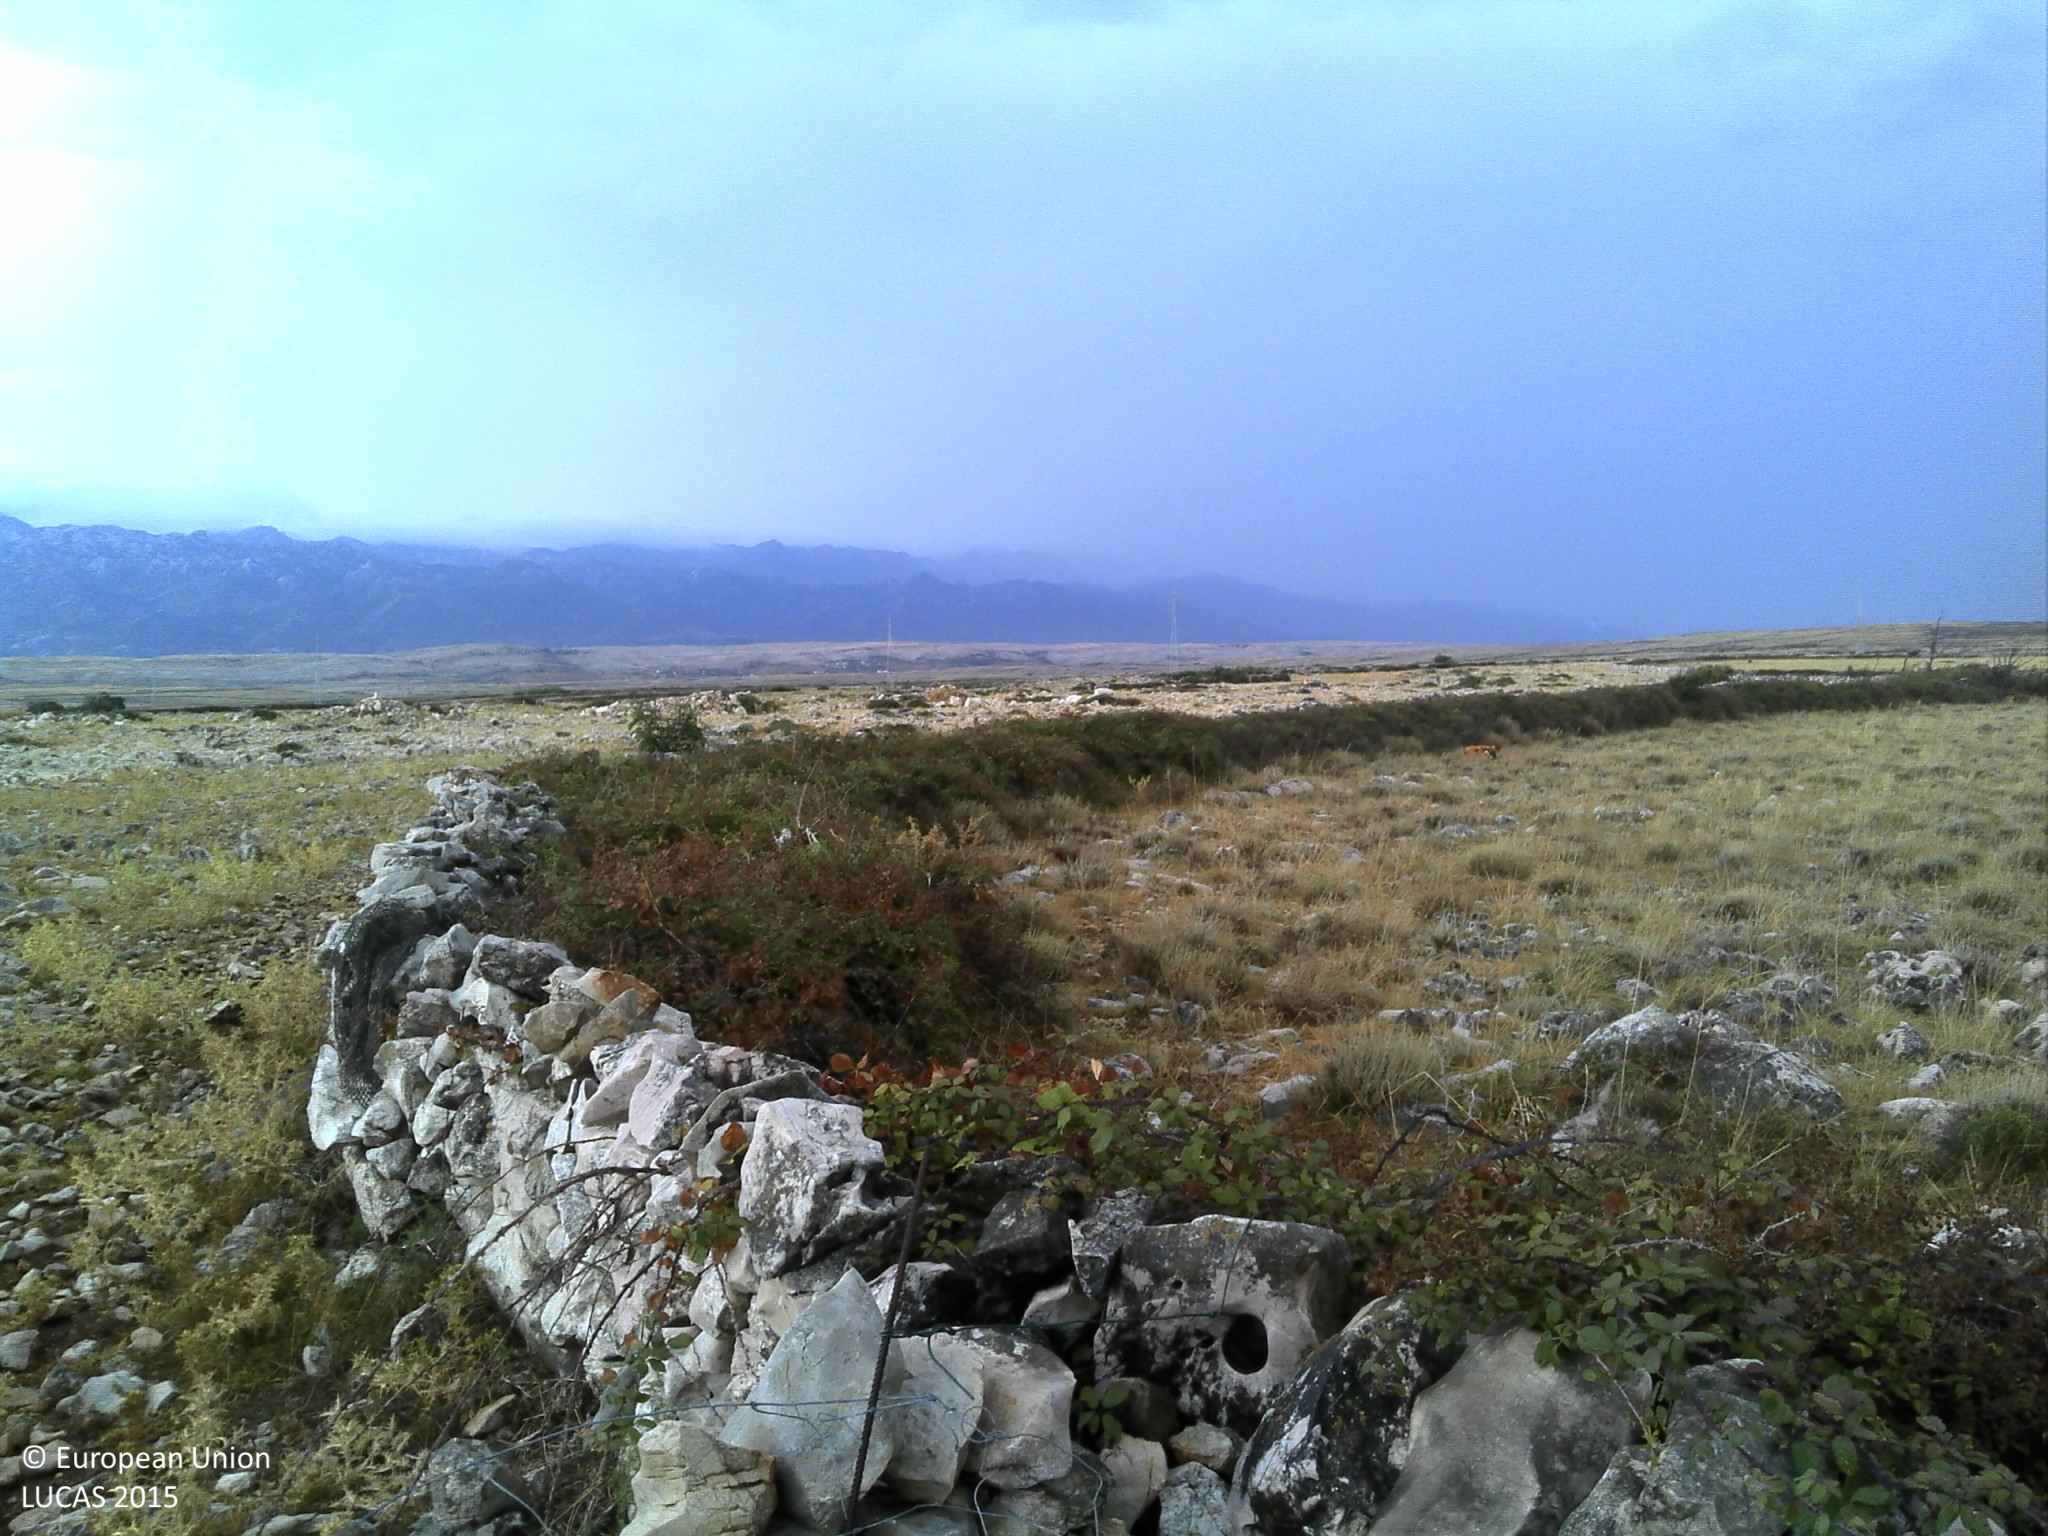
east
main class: Grassland
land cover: Grassland without tree/shrub cover
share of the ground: 50 - 75 %
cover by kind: herbaceous plants 50 %, unconsolidated bare surface 45 %, shrubs 5 %
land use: Agriculture (excluding fallow land and kitchen gardens)
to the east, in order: Grassland without tree/shrub cover; Dry stone walls; Grassland without tree/shrub cover; Artificial constructions in urban areas; Dry stone walls; Rock outcrops; Dry stone walls; Rock outcrops
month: July
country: HR
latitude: 44.3505
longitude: 15.1235
